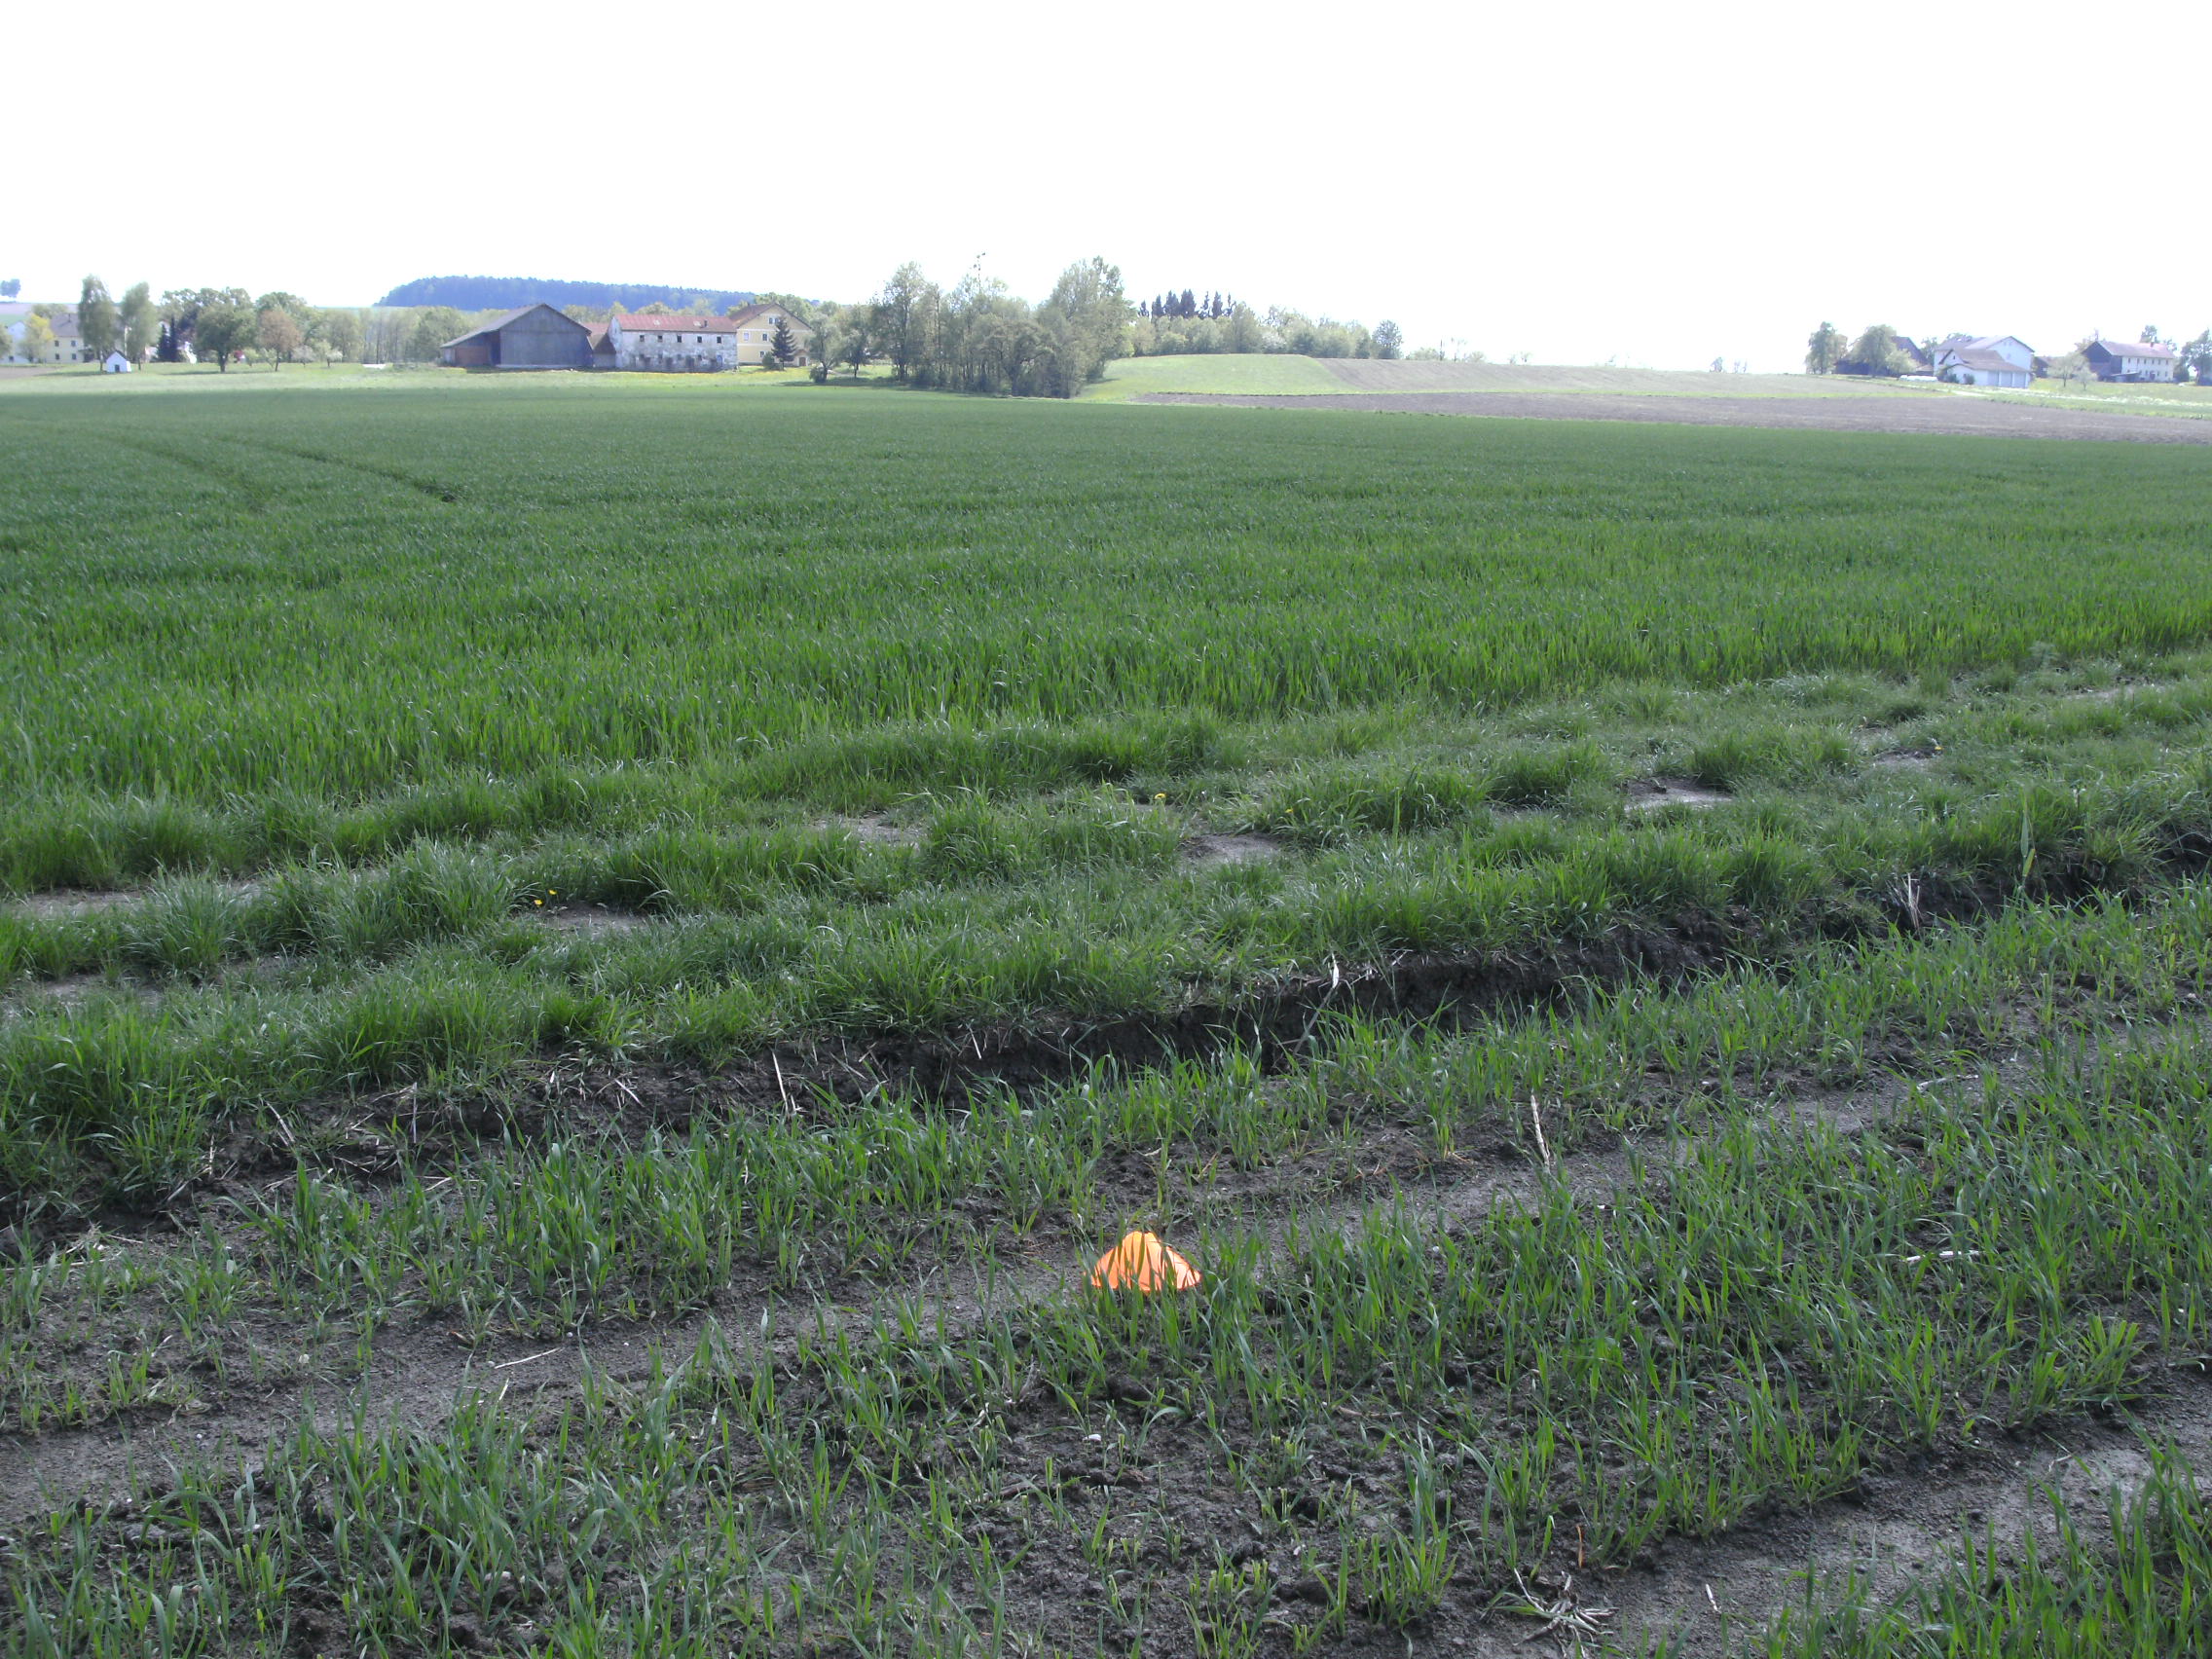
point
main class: Cropland
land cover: Oats
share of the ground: 50 - 75 %
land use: Agriculture (excluding fallow land and kitchen gardens)
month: May
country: AT
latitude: 48.2935
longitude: 13.5174
